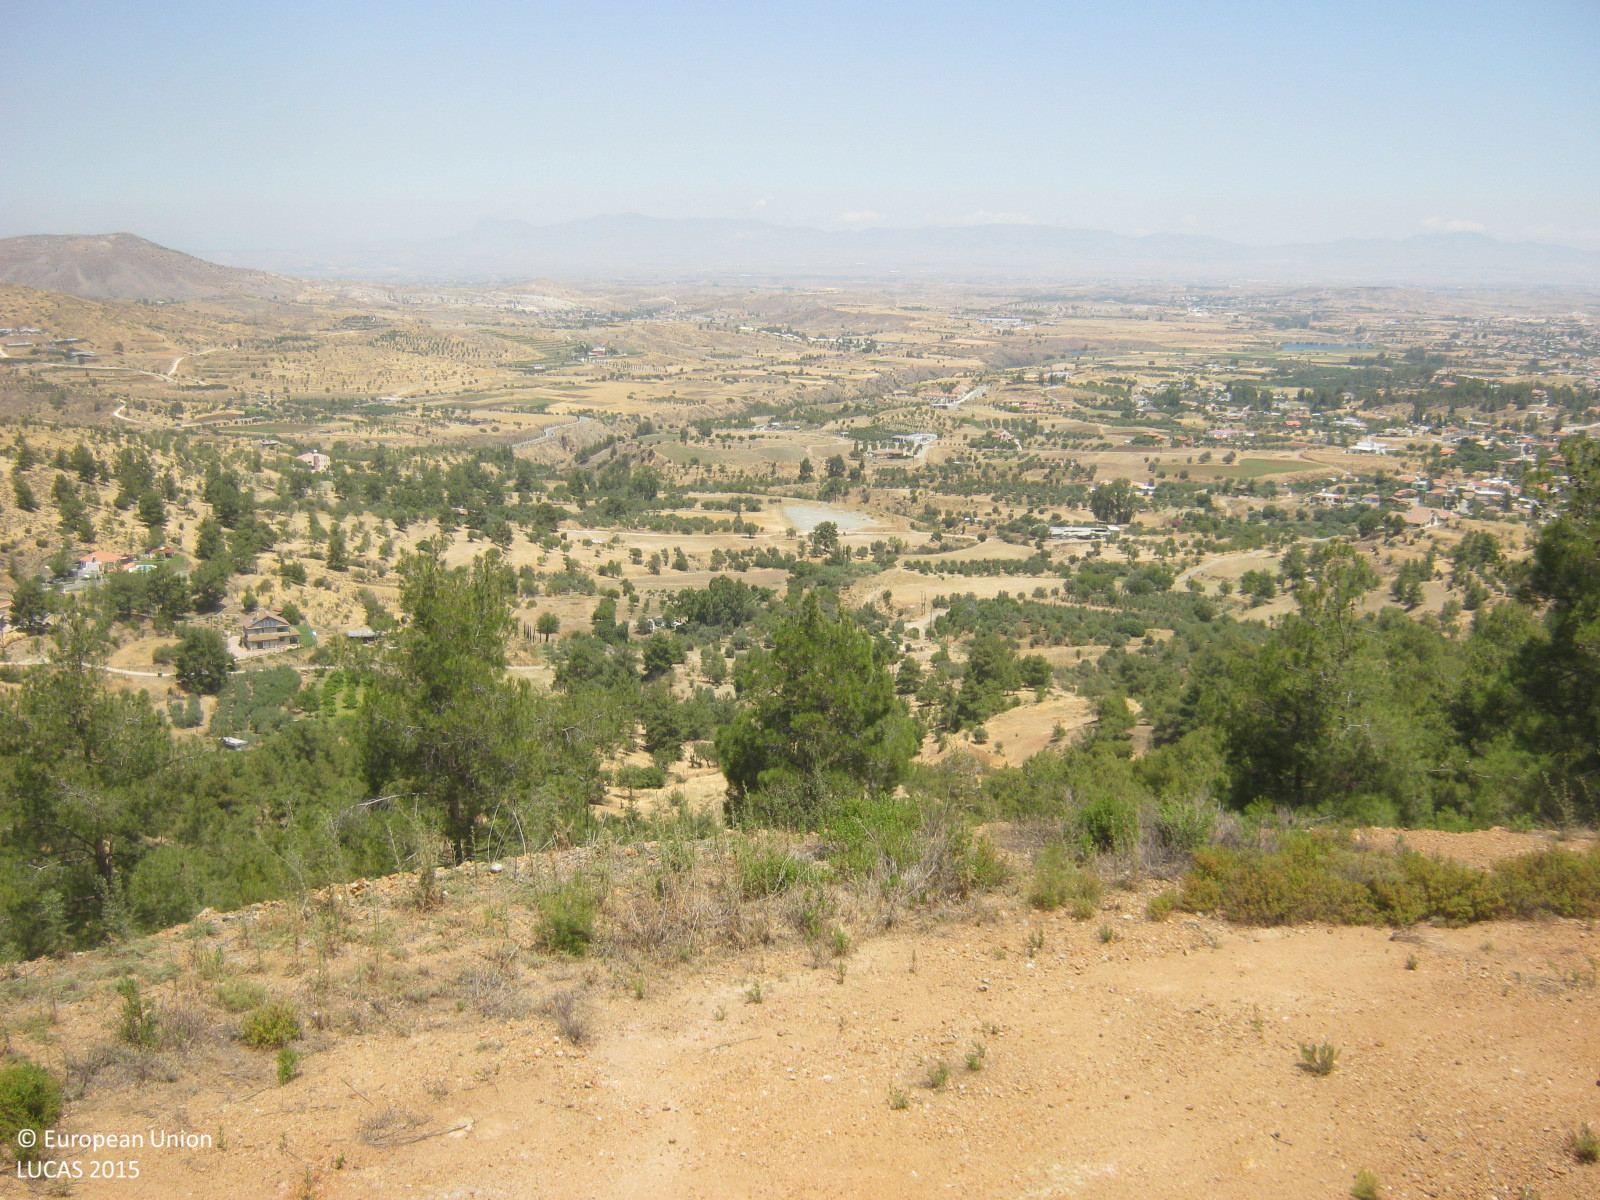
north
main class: Woodland
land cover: Pine dominated coniferous woodland
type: coniferous forest of the mediterranean region
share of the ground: 25 - 50 %
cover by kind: shrubs 55 %, coniferous forest trees 30 %, unconsolidated bare surface 10 %, consolidated bare surface 5 %
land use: Forestry
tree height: > 5 m
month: June
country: CY
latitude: 34.9979
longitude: 33.1557
